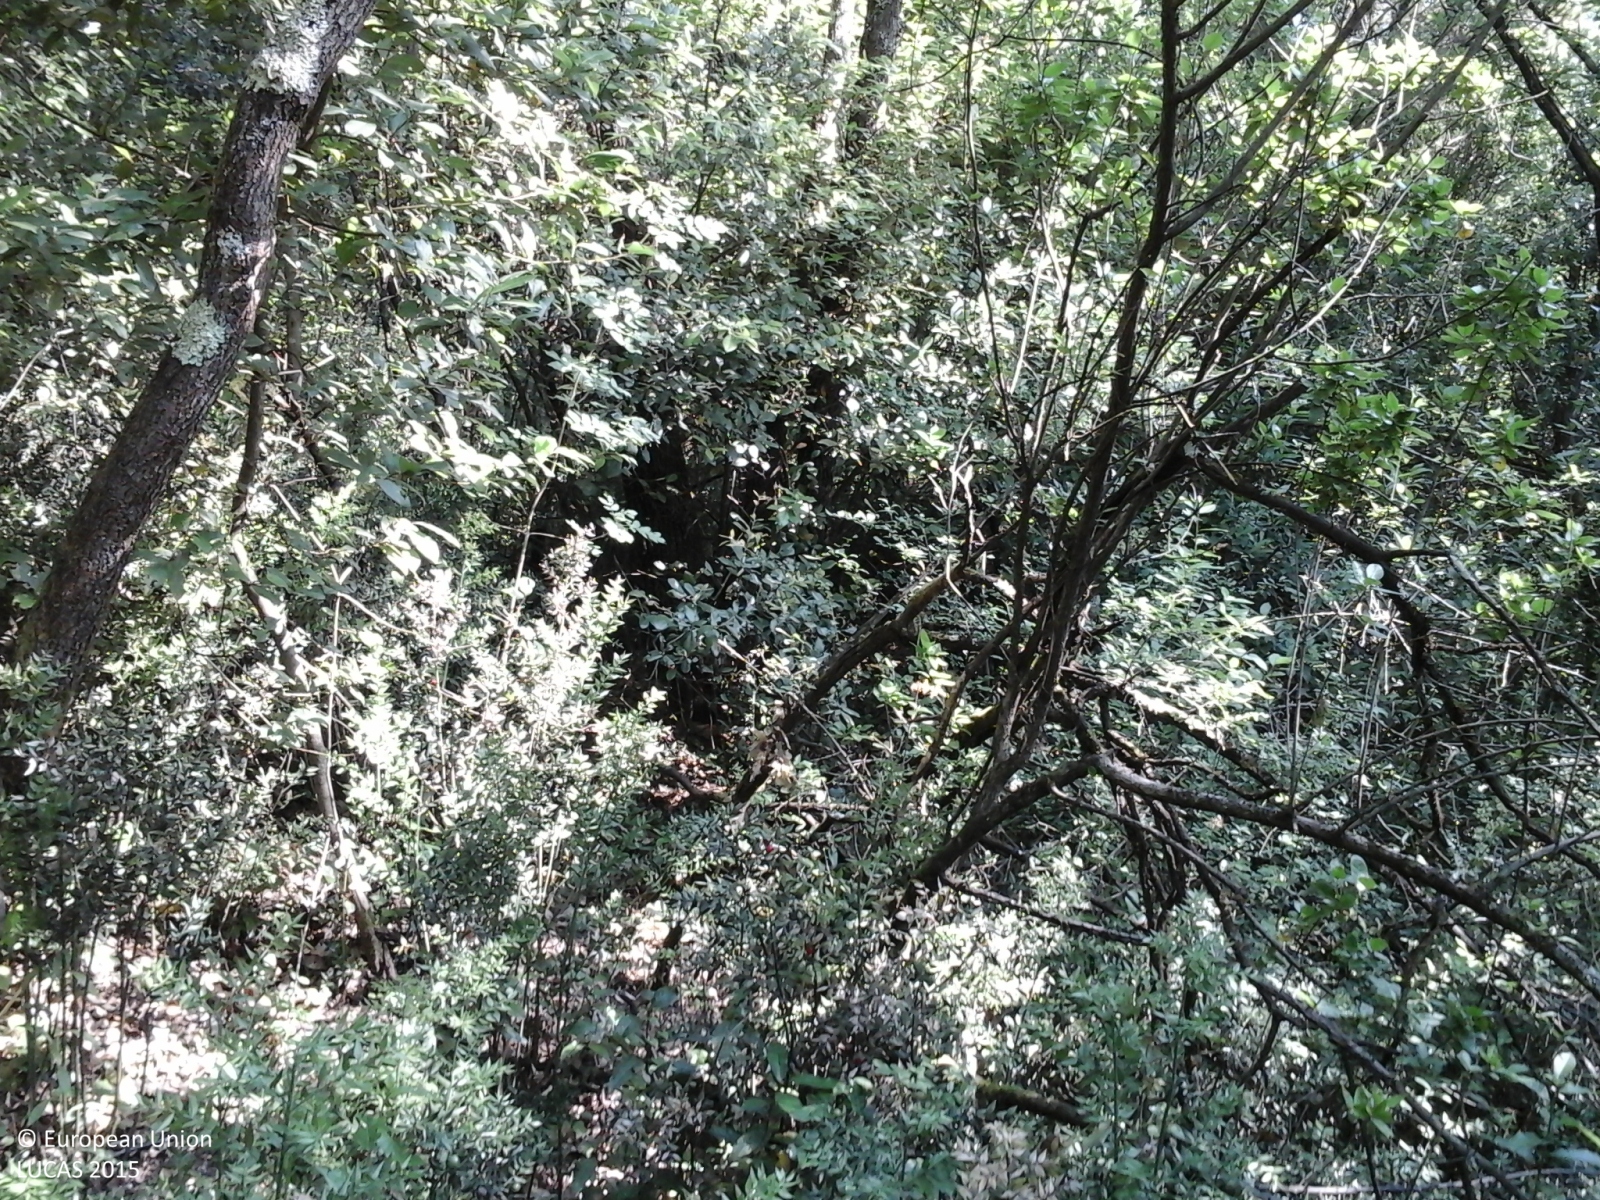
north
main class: Woodland
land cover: Other mixed woodland
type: thermophilous deciduous forest
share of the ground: > 75 %
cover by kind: broadleaved forest trees 50 %, coniferous forest trees 40 %, shrubs 10 %
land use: Forestry
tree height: > 5 m
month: June
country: IT
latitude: 43.8751
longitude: 11.1544
